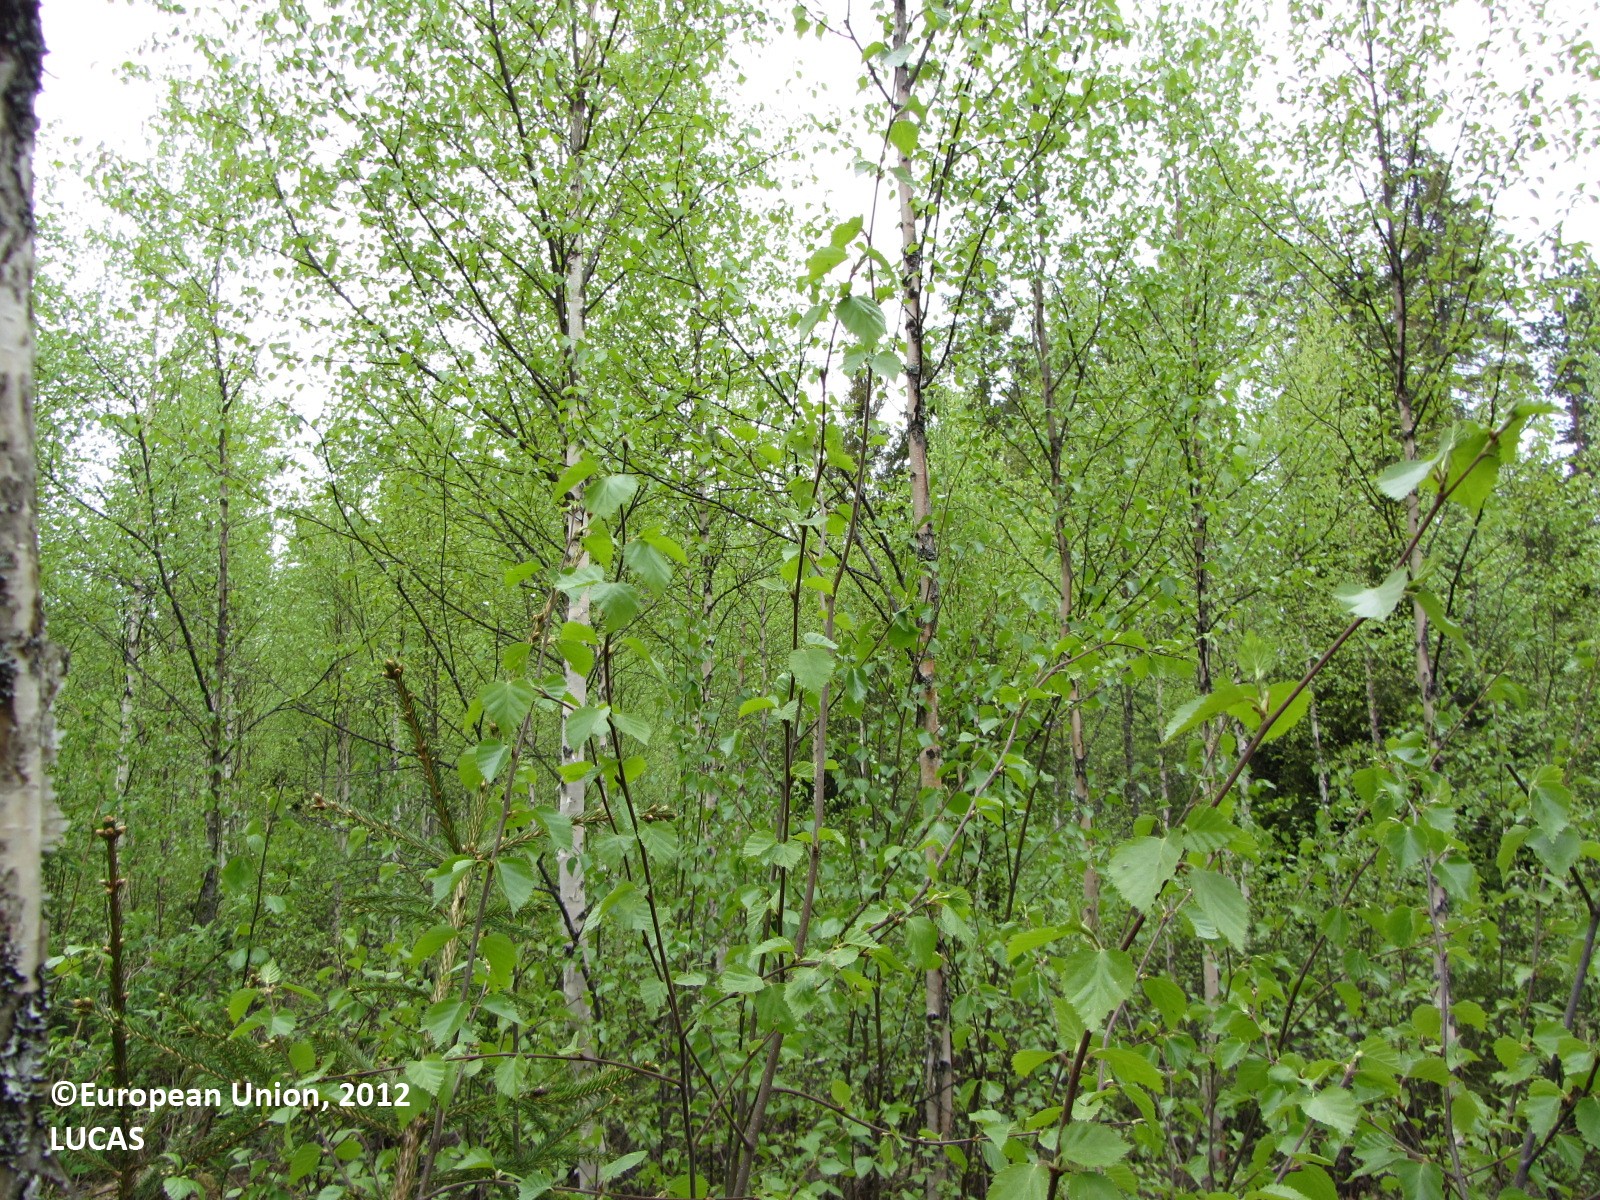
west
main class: Woodland
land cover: Broadleaved woodland
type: hemiboreal forest and nemoral coniferous forest and mixed broadleaved-coniferous forest
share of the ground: > 75 %
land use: Forestry
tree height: > 5 m
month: May
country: FI
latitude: 62.4092
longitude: 25.3403
